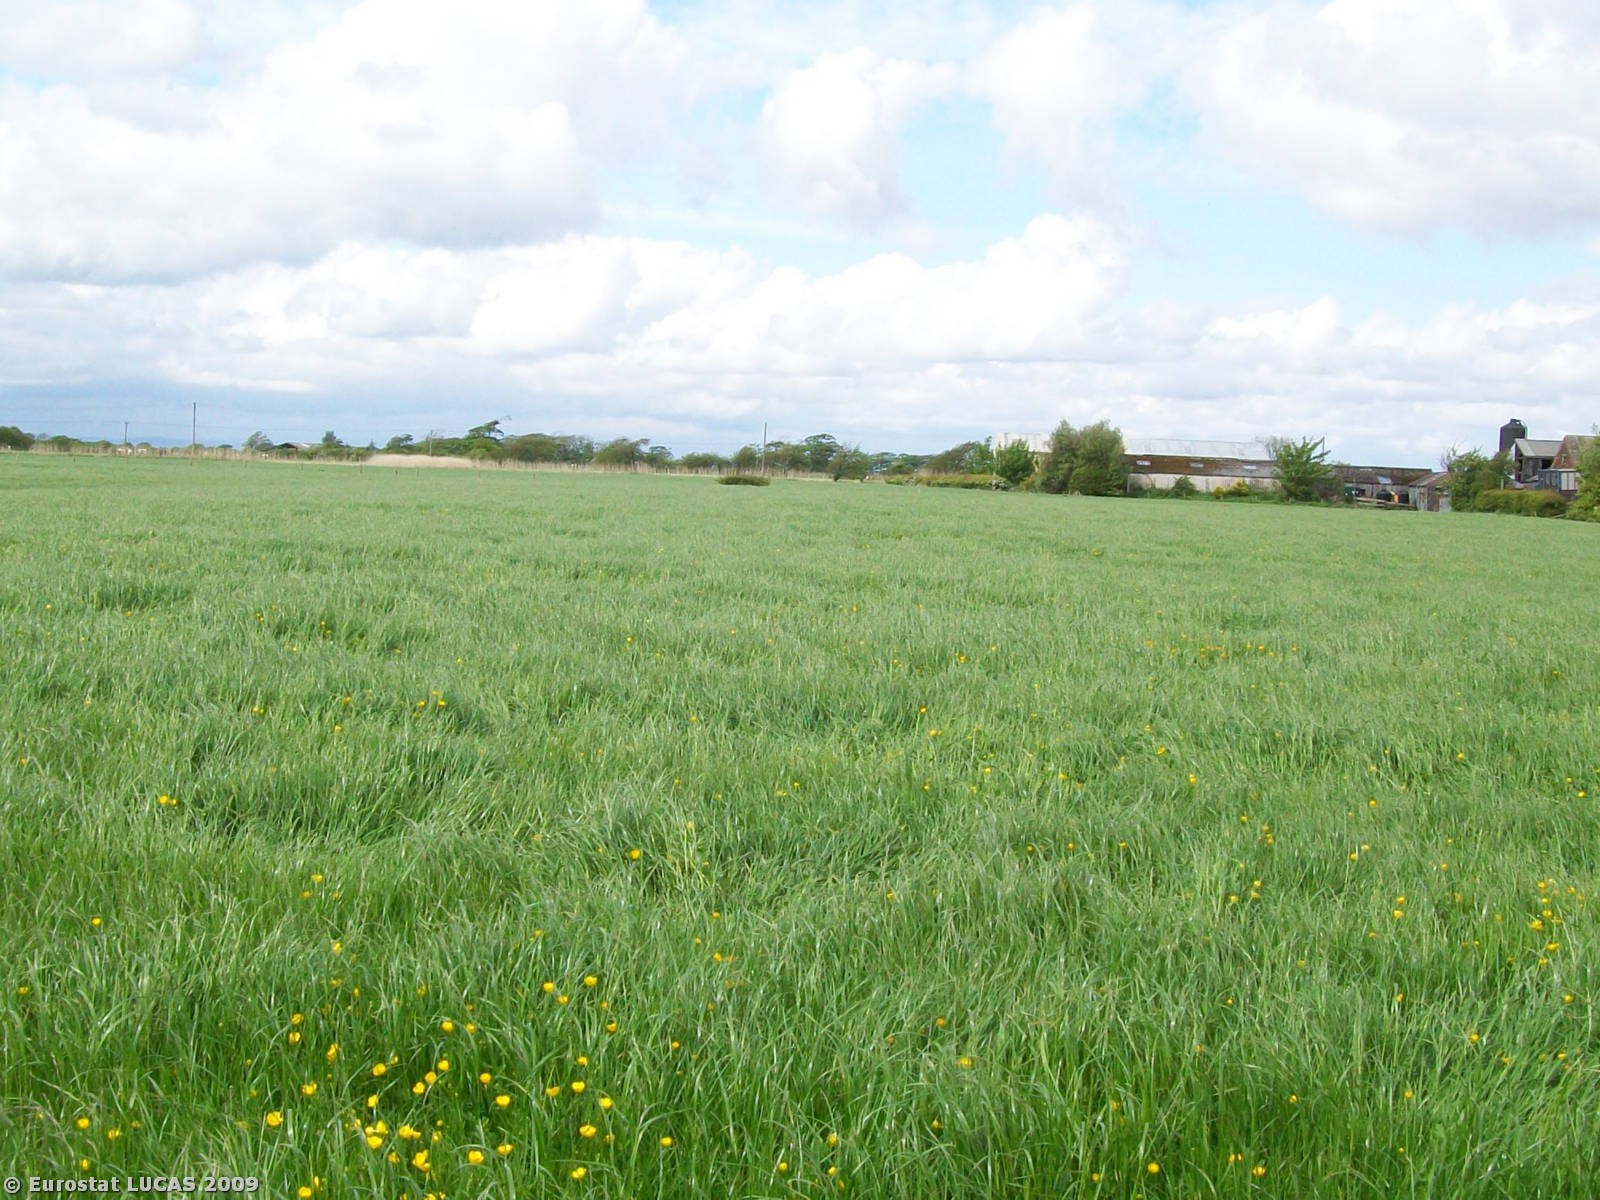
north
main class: Grassland
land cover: Grassland without tree/shrub cover
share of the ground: 25 - 50 %
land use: Agriculture (excluding fallow land and kitchen gardens)
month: May
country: GB
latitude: 53.9247
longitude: -2.9403
